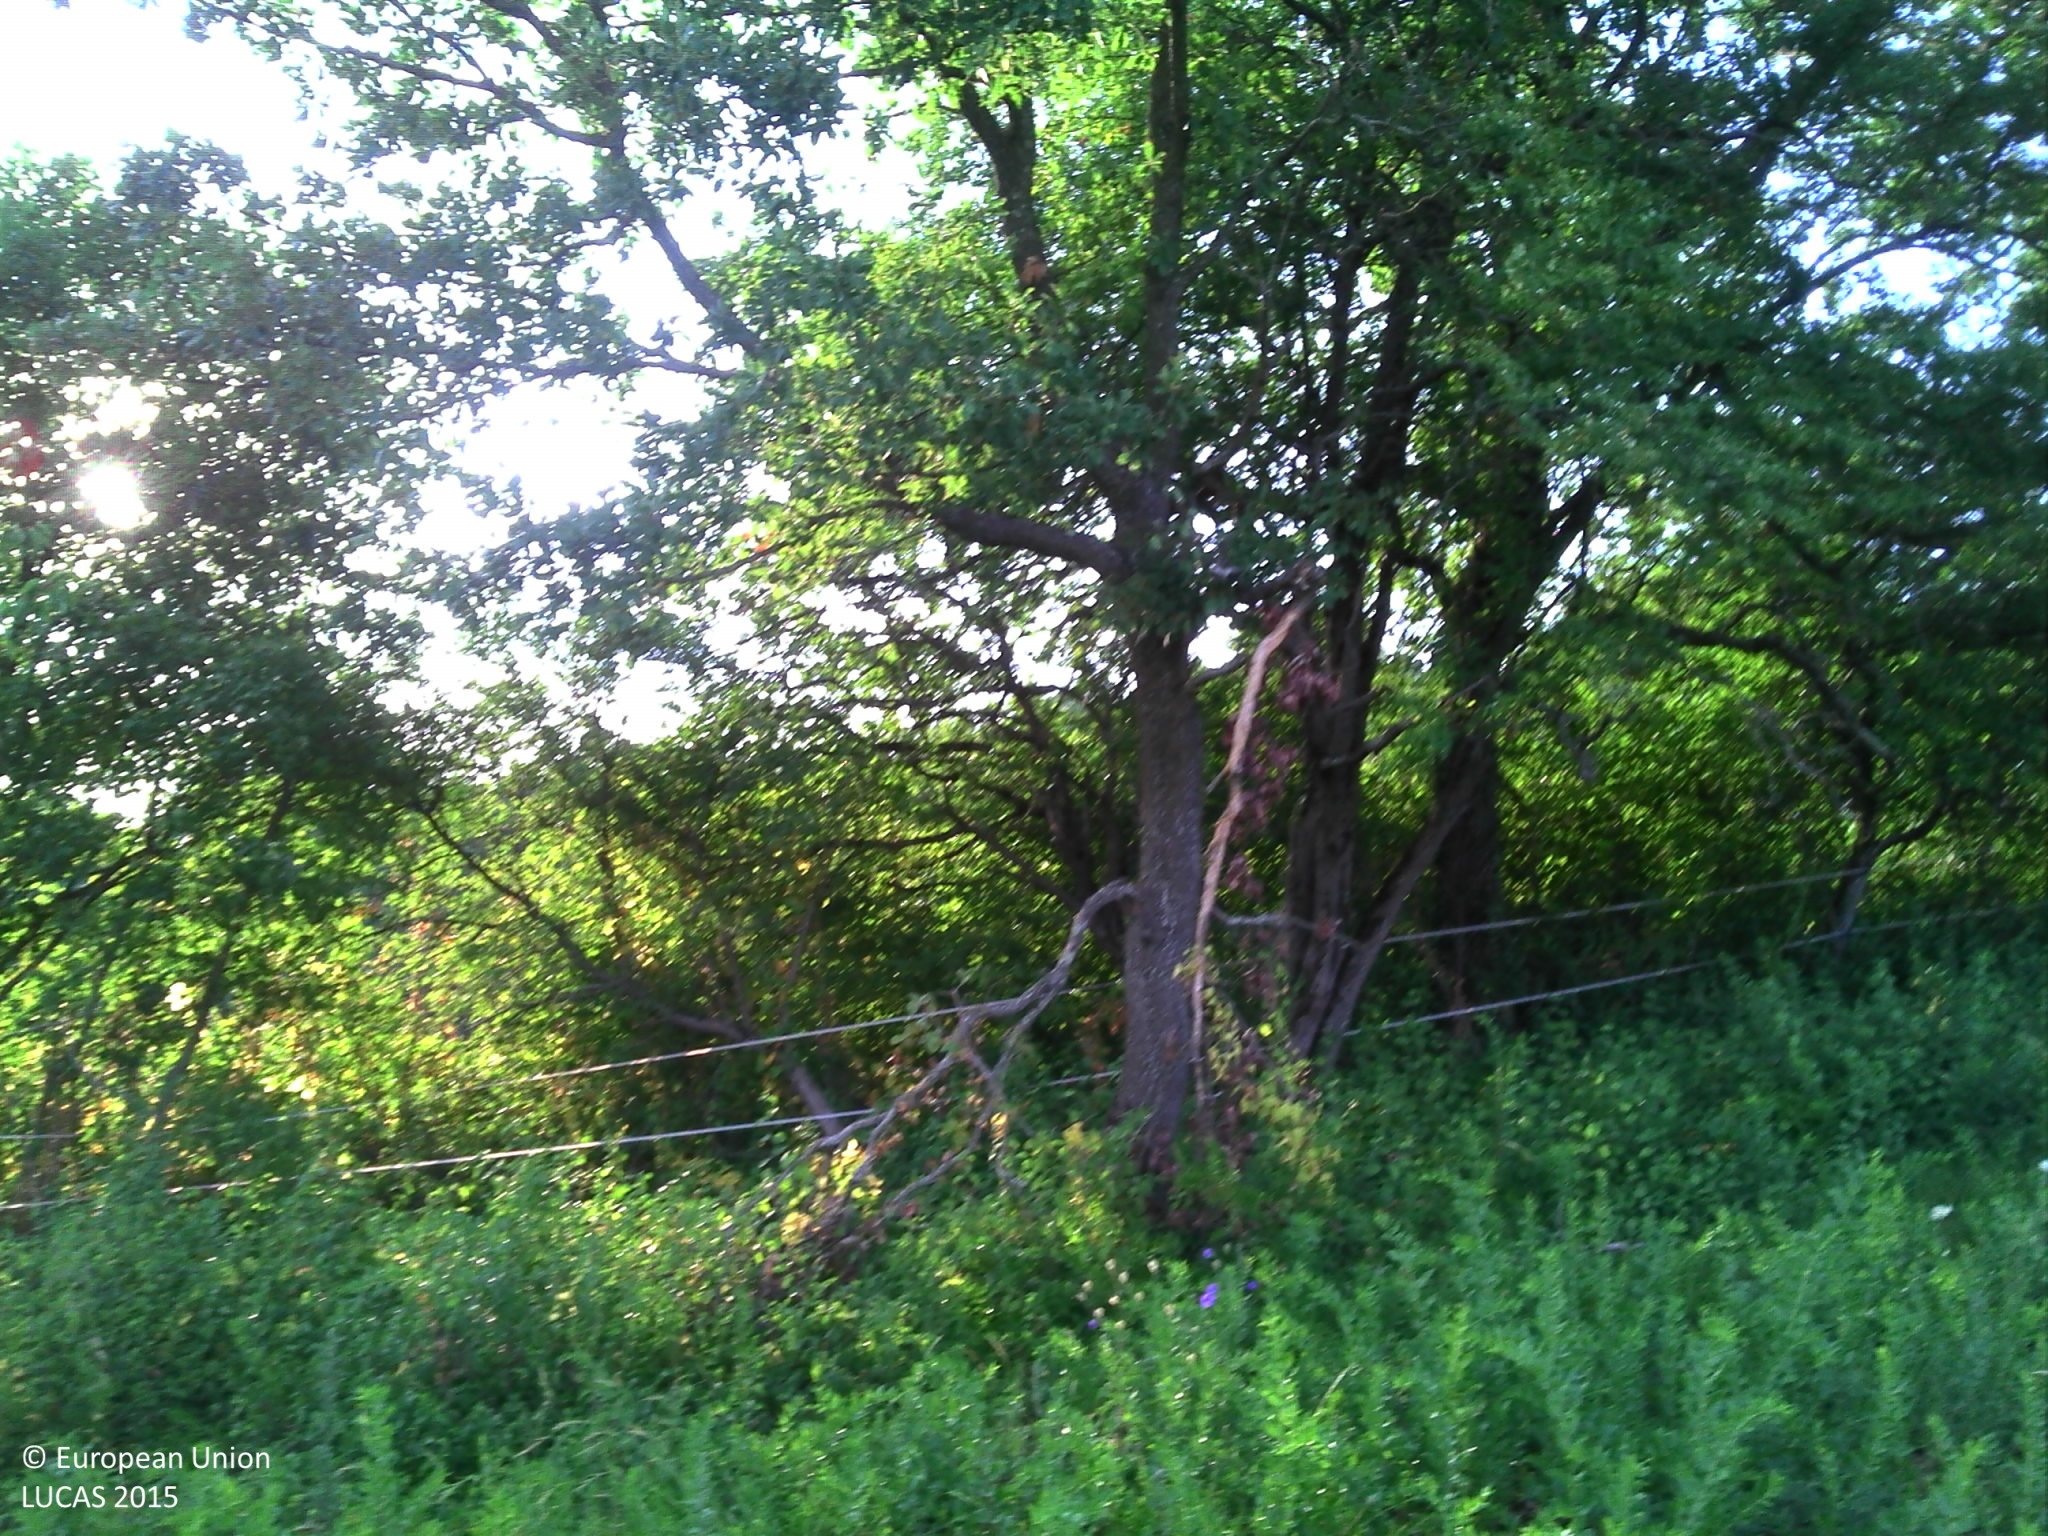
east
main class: Shrubland
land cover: Shrubland without tree cover
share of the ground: > 75 %
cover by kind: herbaceous plants 70 %, shrubs 30 %
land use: Agriculture (excluding fallow land and kitchen gardens)
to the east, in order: Shrubland without tree cover; Fences; Broadleaved woodland; Fences; Shrubland without tree cover; Fences; Spontaneously vegetated surfaces; Broadleaved woodland; Fences; Grassland without tree/shrub cover; Fences; Broadleaved woodland; Fences; Broadleaved woodland; Grassland without tree/shrub cover
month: July
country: FR
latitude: 43.1698
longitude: 1.7526
